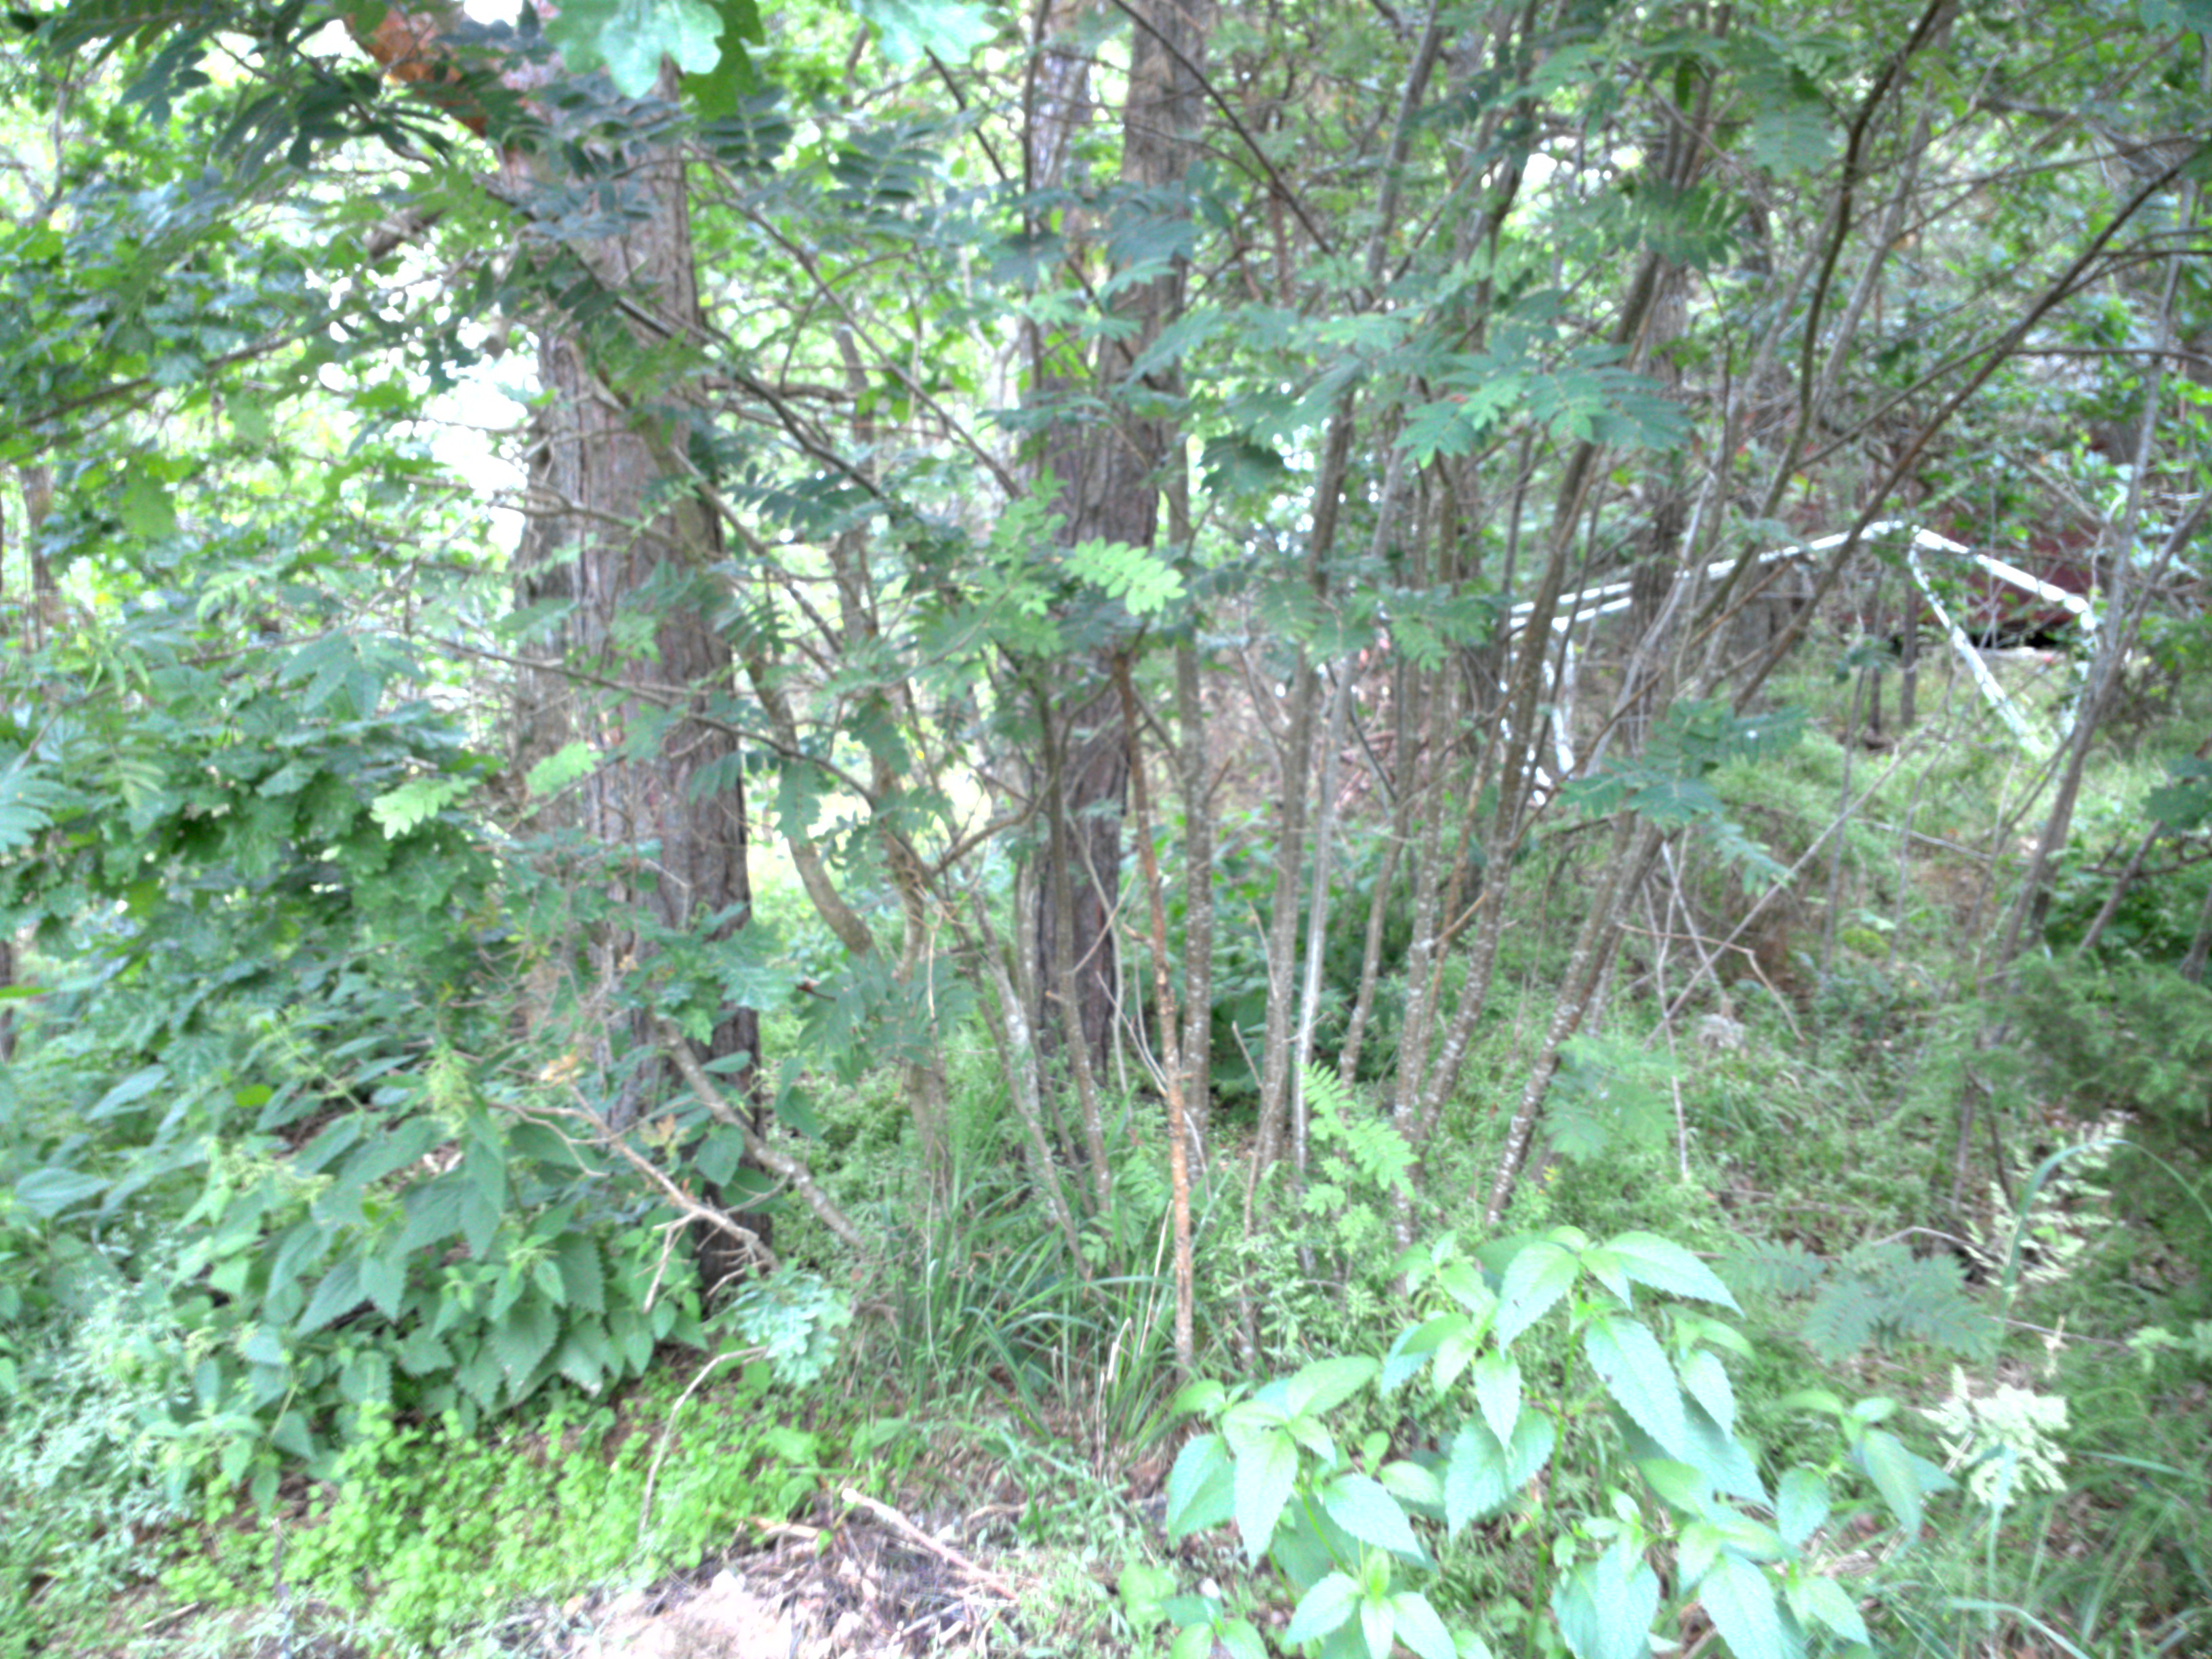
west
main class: Woodland
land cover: Broadleaved woodland
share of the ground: 50 - 75 %
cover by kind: broadleaved forest trees 55 %, herbaceous plants 35 %, coniferous forest trees 10 %
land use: Residential
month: July
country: SE
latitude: 59.1347
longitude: 18.3720
